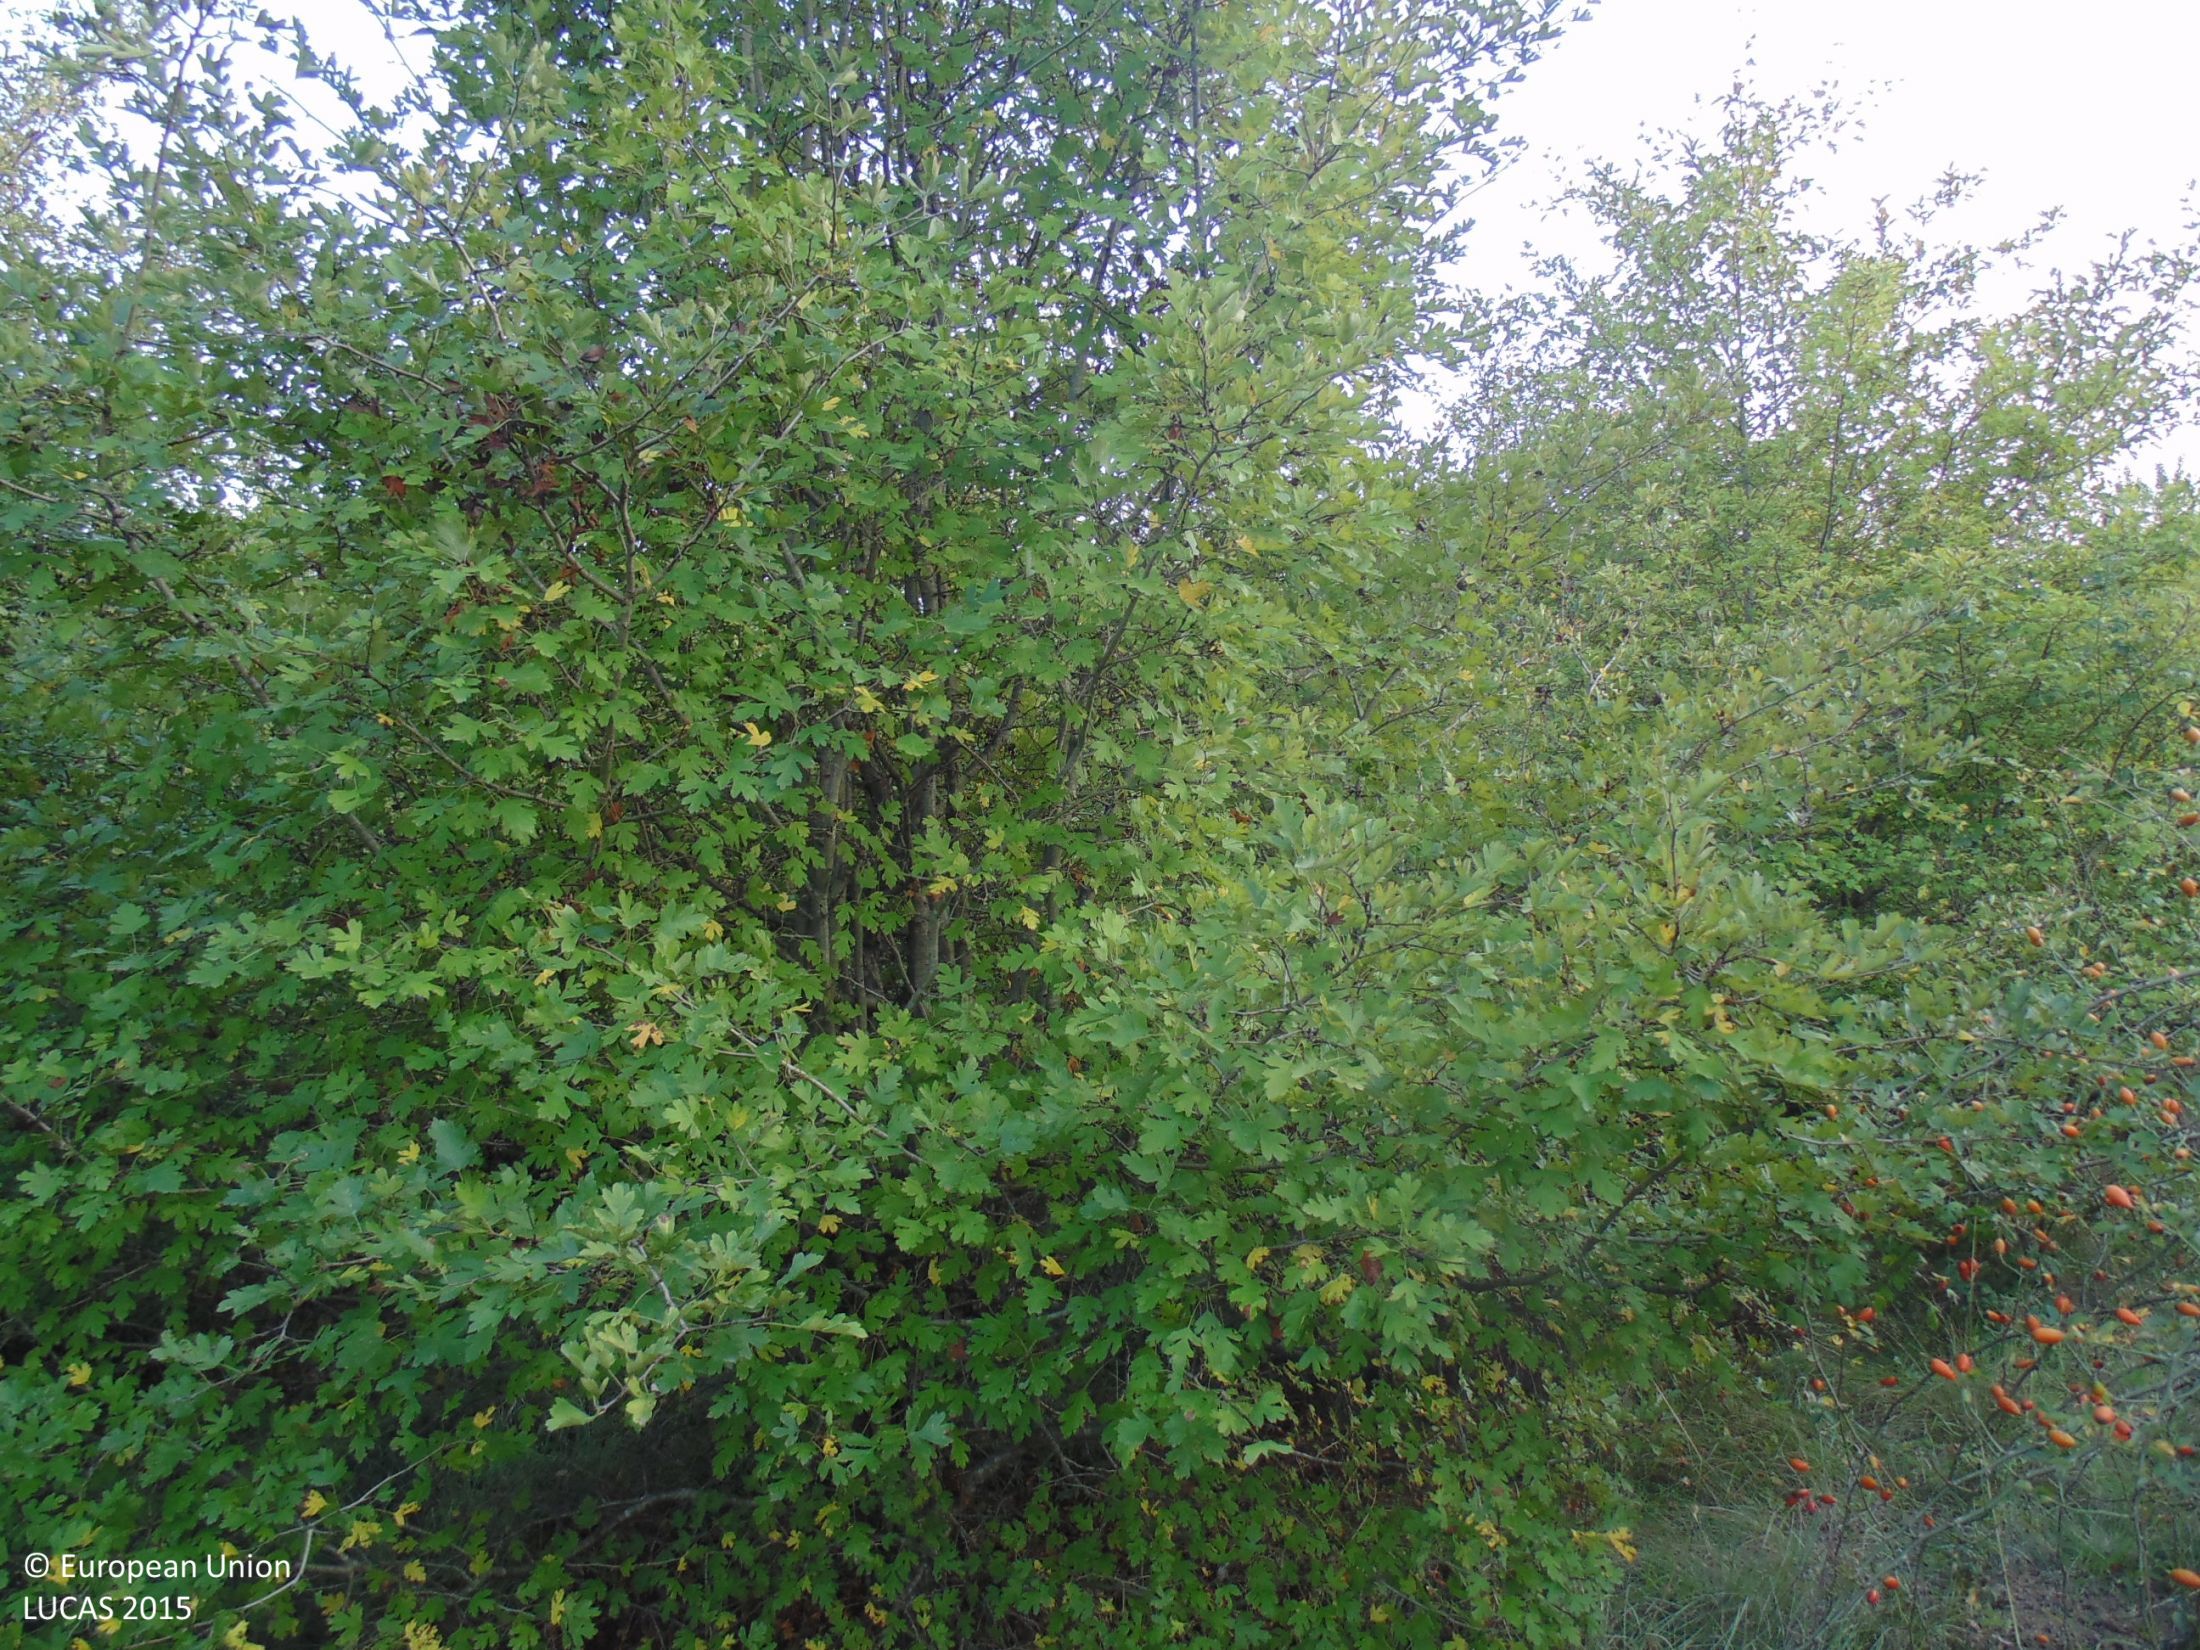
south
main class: Woodland
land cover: Broadleaved woodland
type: mesophytic deciduous forest
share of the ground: > 75 %
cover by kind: broadleaved forest trees 70 %, shrubs 20 %, herbaceous plants 10 %
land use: Forestry
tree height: < 5 m
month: August
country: BG
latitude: 43.8971
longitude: 27.2979
